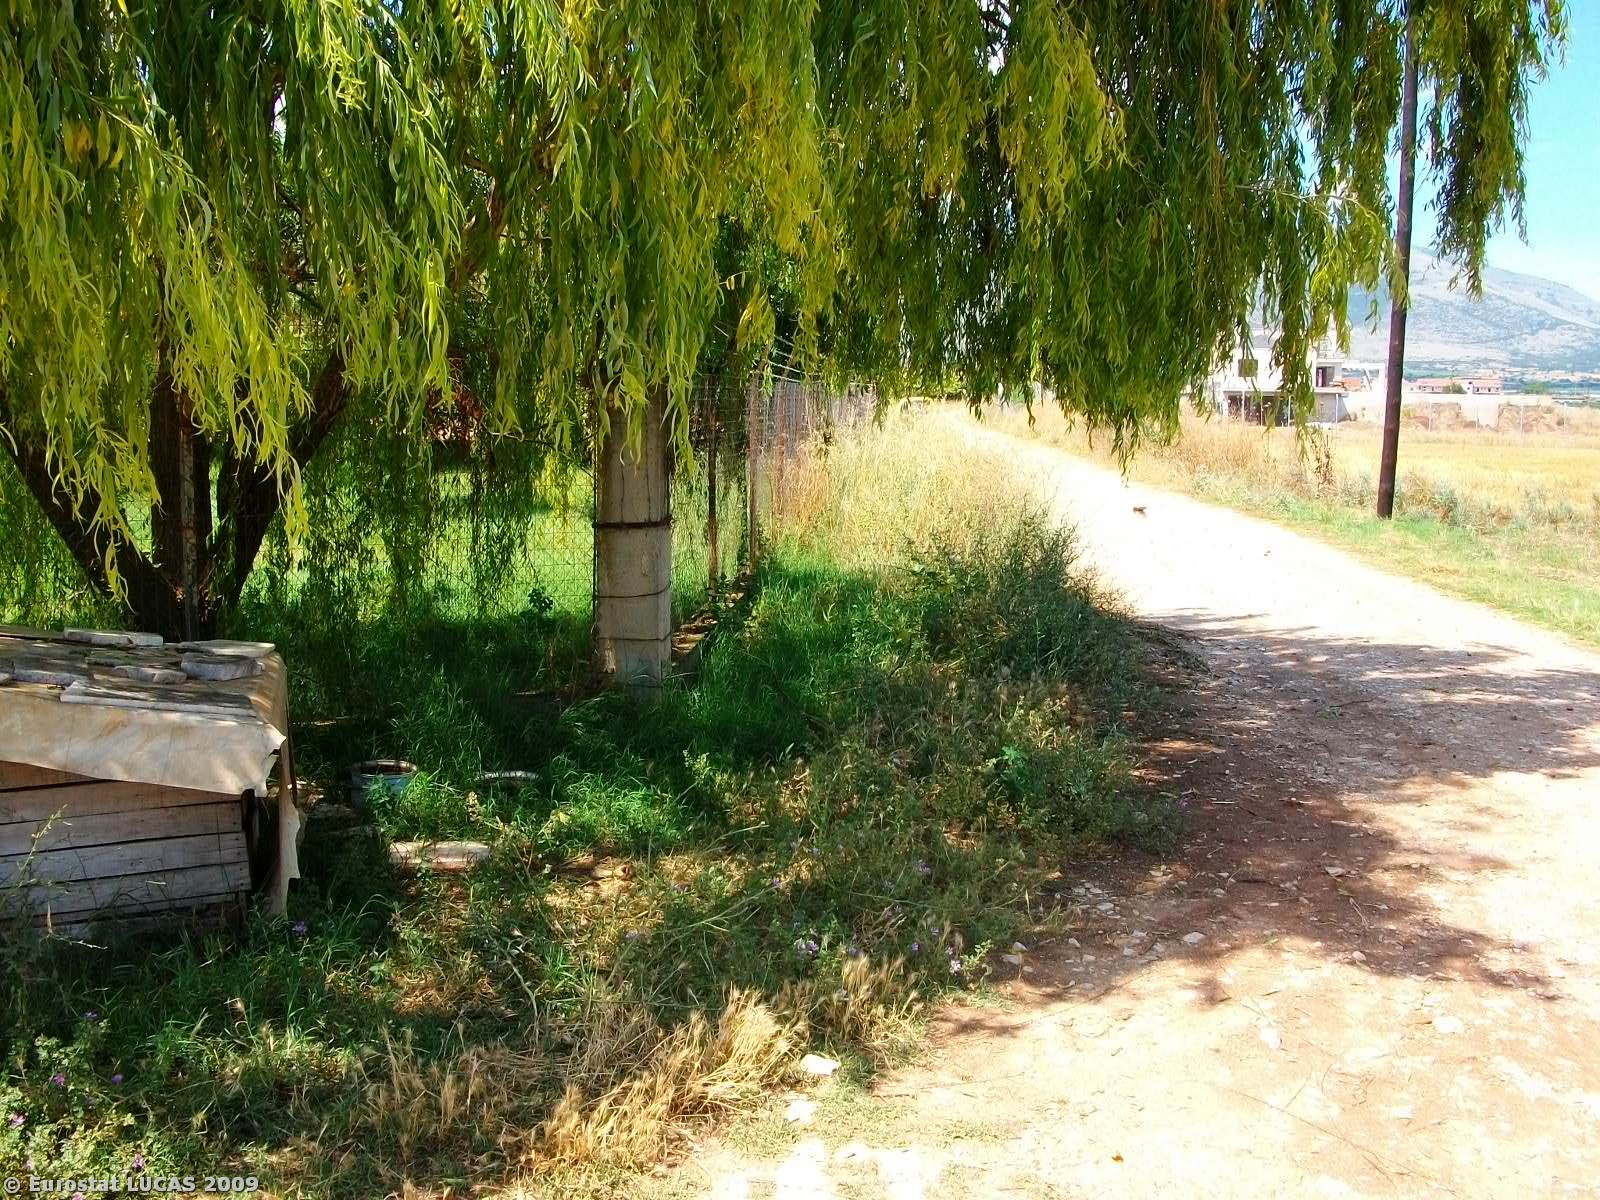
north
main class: Cropland
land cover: Nuts trees
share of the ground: 50 - 75 %
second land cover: Grassland with sparse tree/shrub cover
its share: > 75 %
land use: Kitchen garden
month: June
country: GR
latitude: 41.1493
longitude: 24.1008
